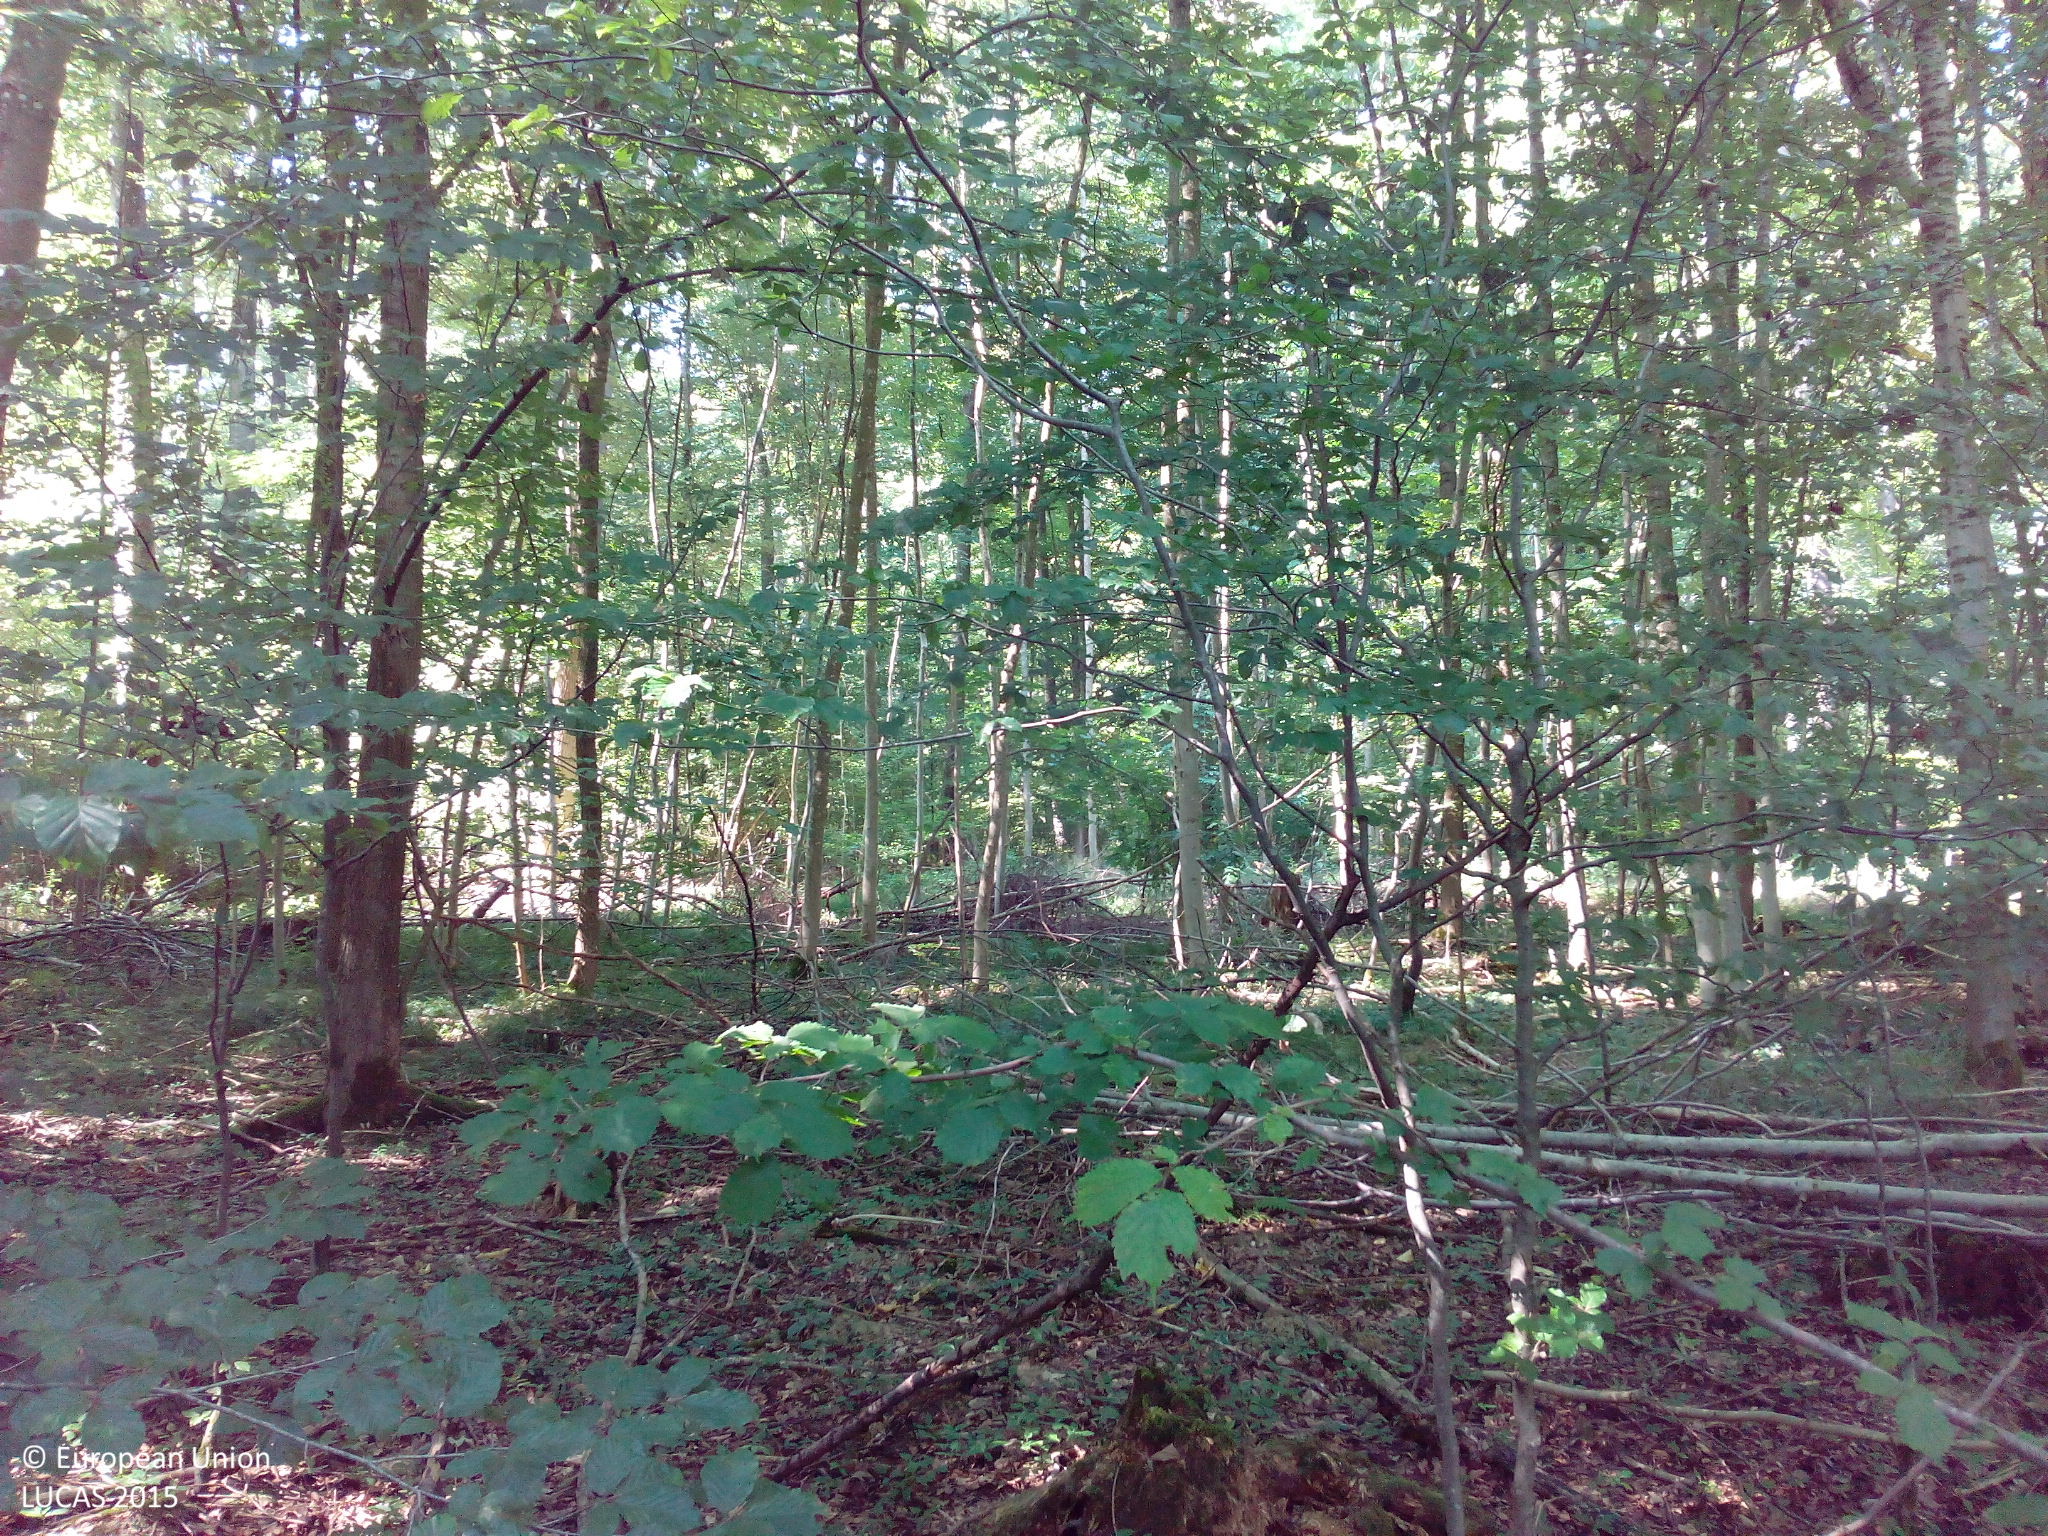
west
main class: Woodland
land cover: Broadleaved woodland
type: mesophytic deciduous forest
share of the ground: > 75 %
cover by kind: broadleaved forest trees 90 %, shrubs 5 %, unconsolidated bare surface 5 %
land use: Forestry
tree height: > 5 m
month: August
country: DE
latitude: 48.6551
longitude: 10.2578
